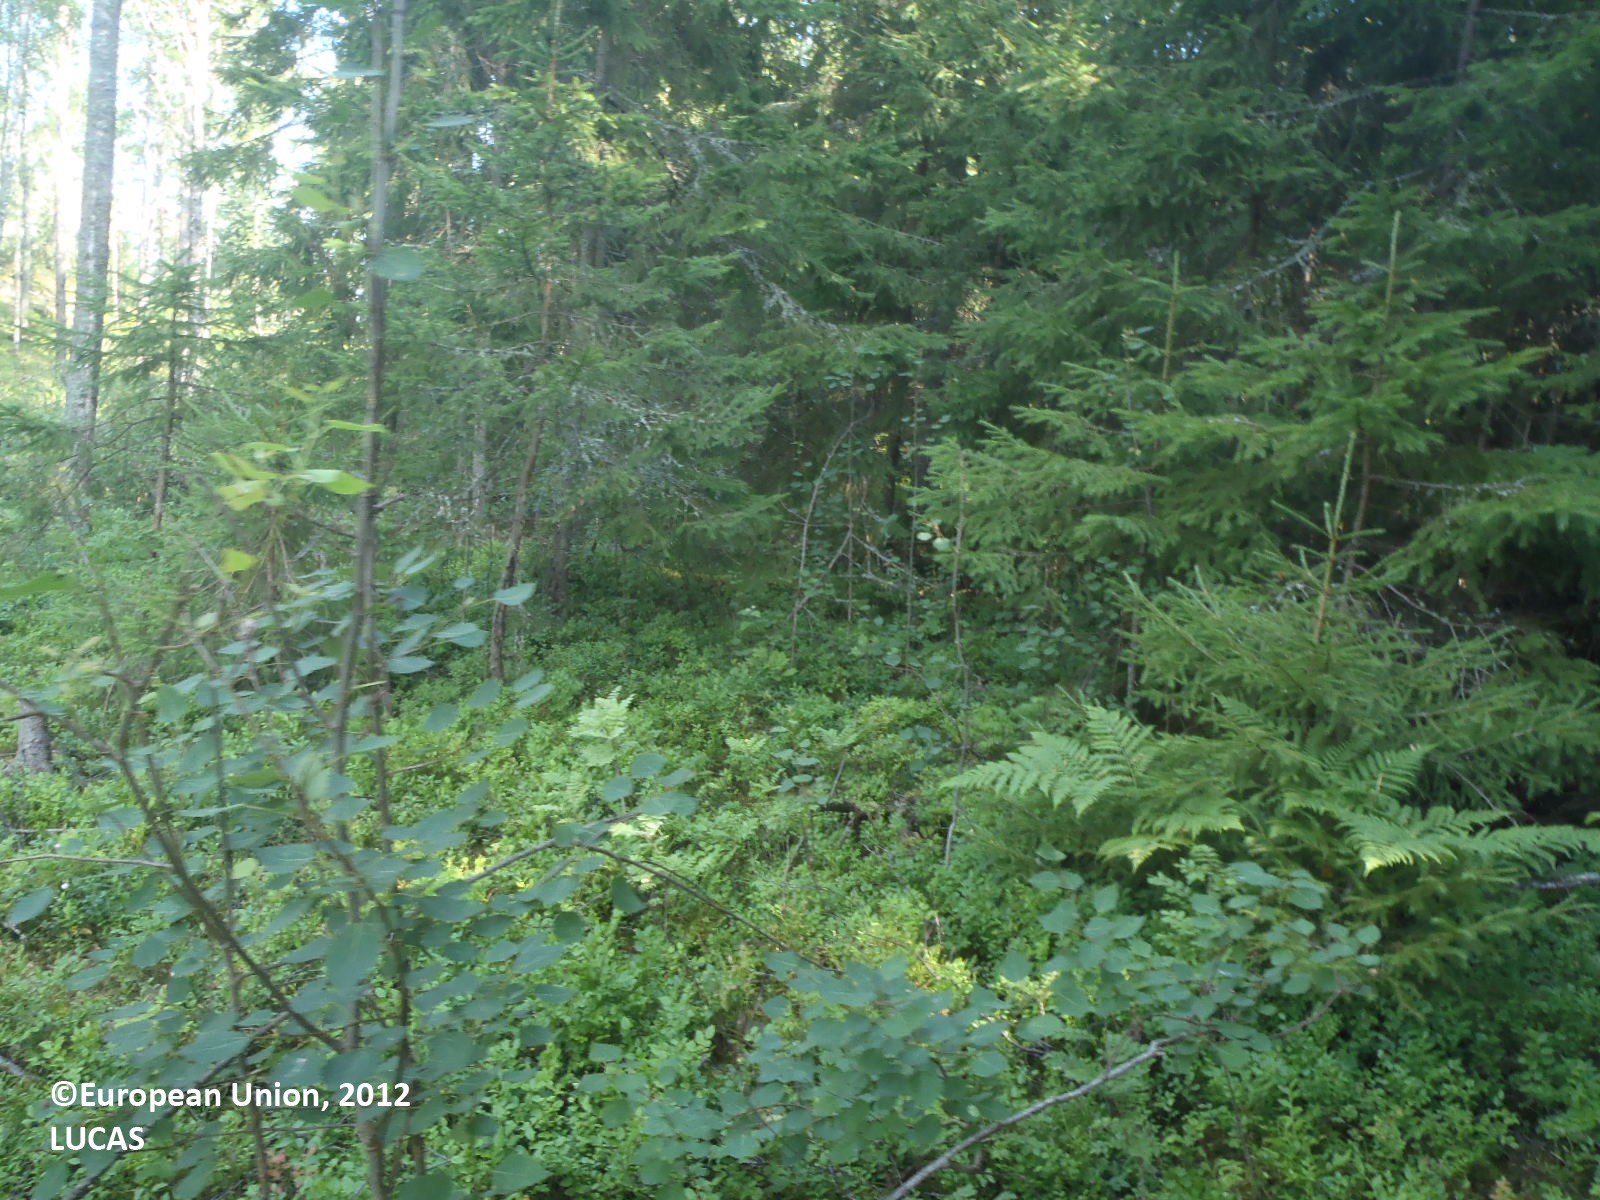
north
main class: Woodland
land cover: Spruce dominated mixed woodland
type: boreal forest
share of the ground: > 75 %
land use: Forestry
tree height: > 5 m
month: July
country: FI
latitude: 60.3724
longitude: 22.2721
